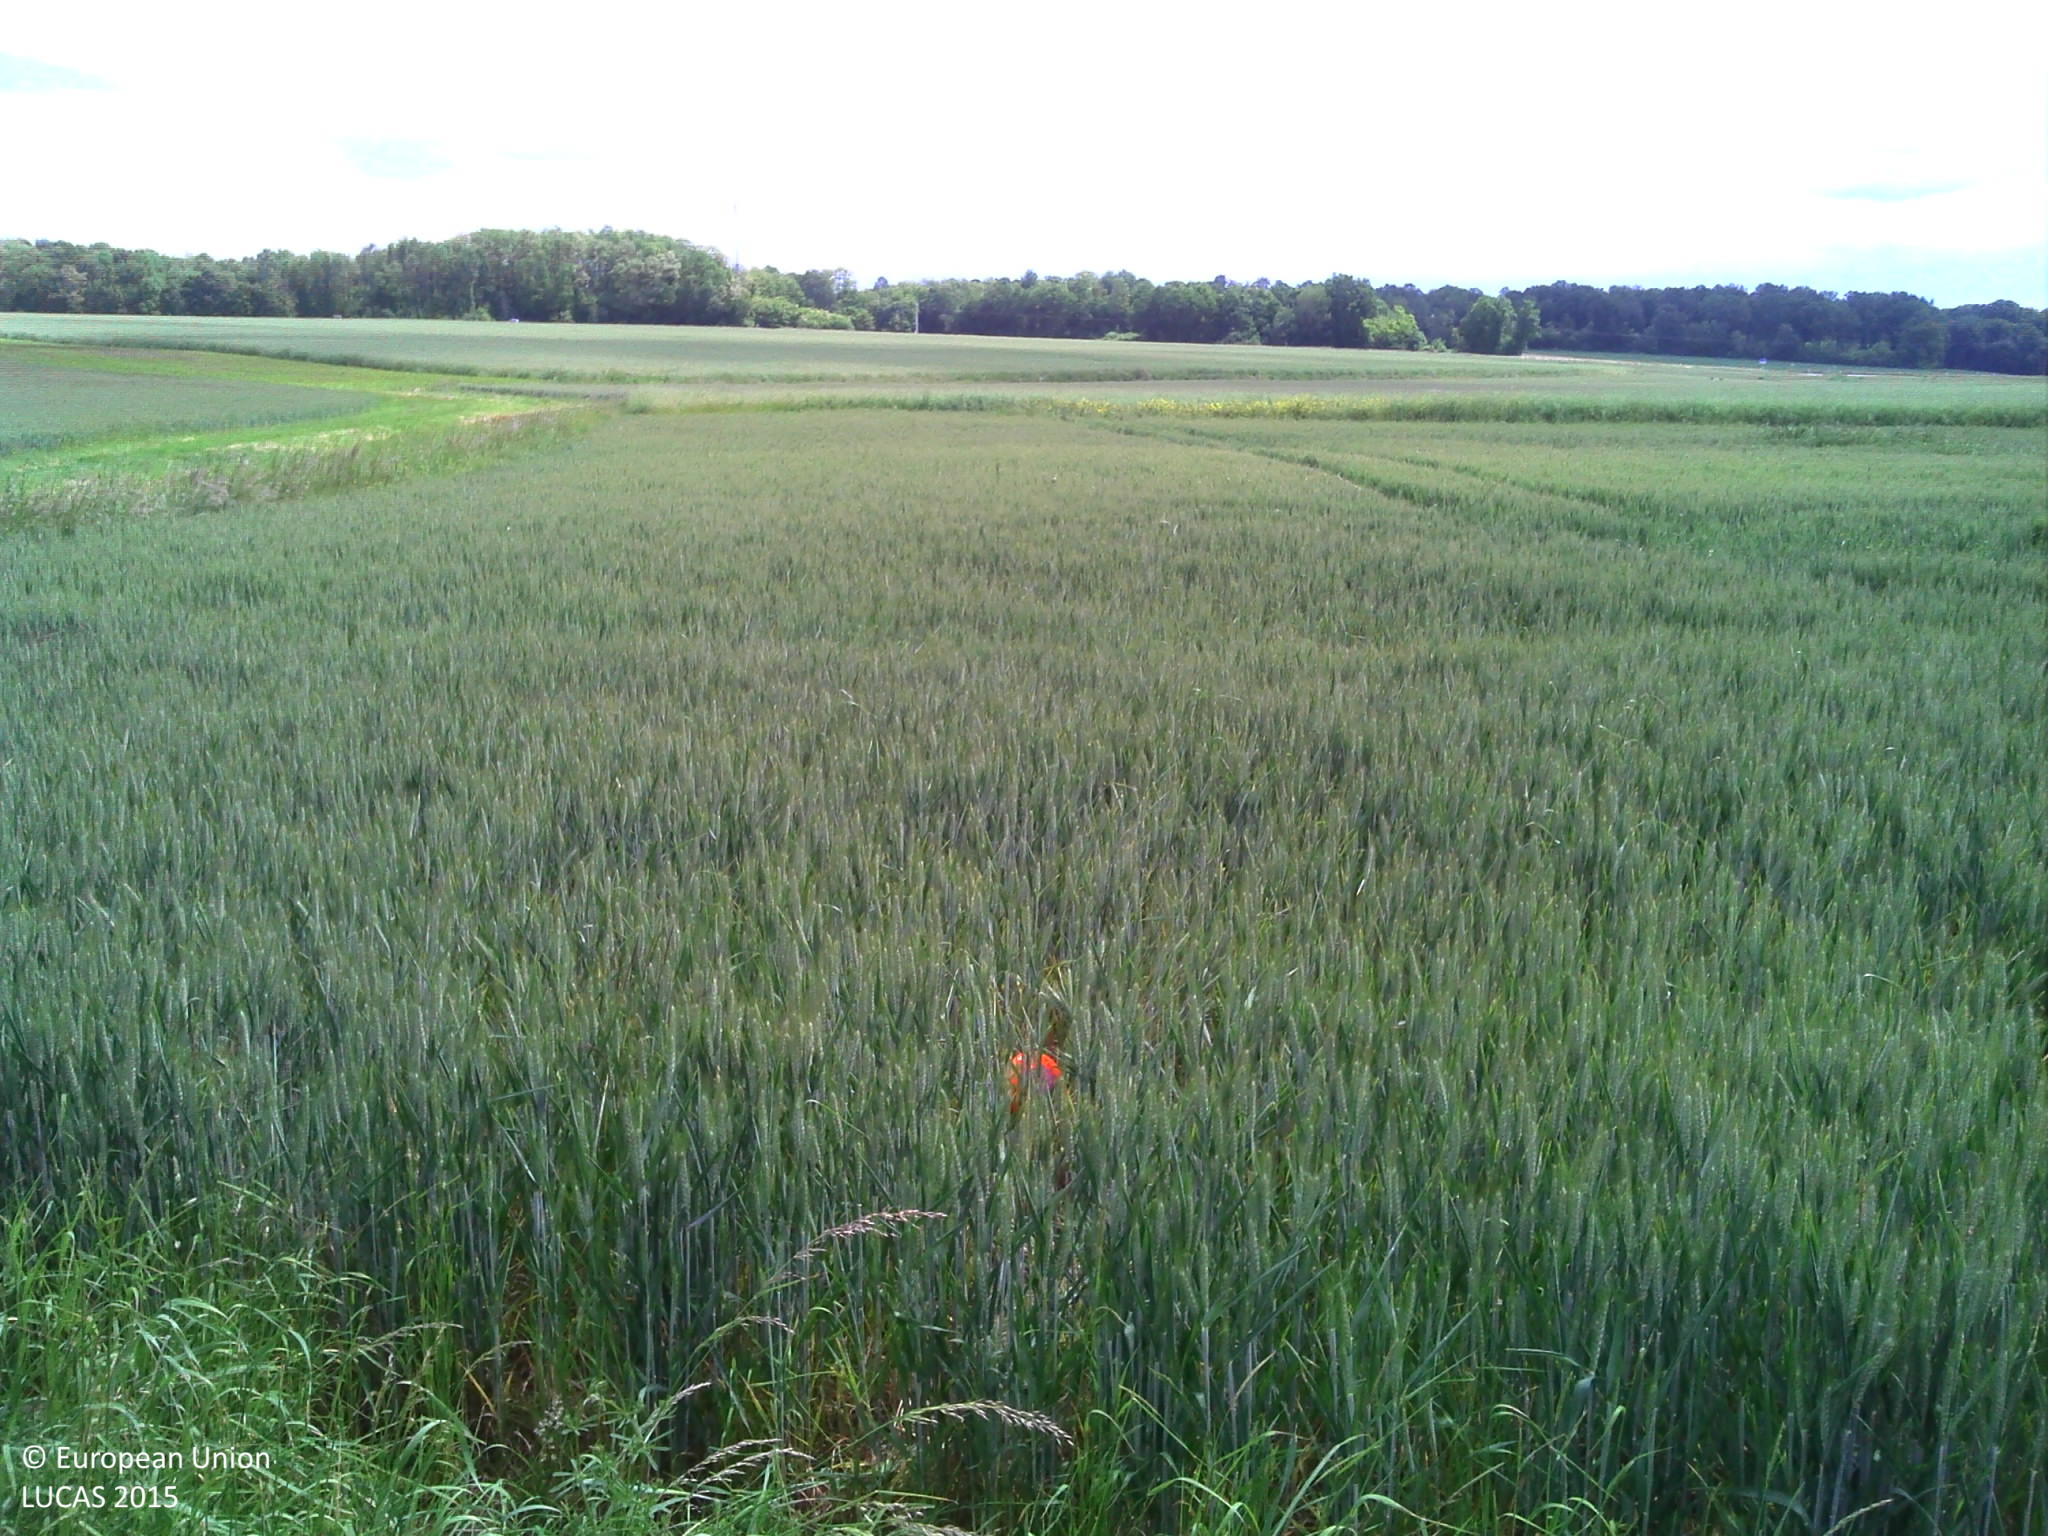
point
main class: Cropland
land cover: Common wheat
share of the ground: > 75 %
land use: Agriculture (excluding fallow land and kitchen gardens)
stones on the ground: < 10 %
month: May
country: FR
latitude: 47.4201
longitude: 5.2951
